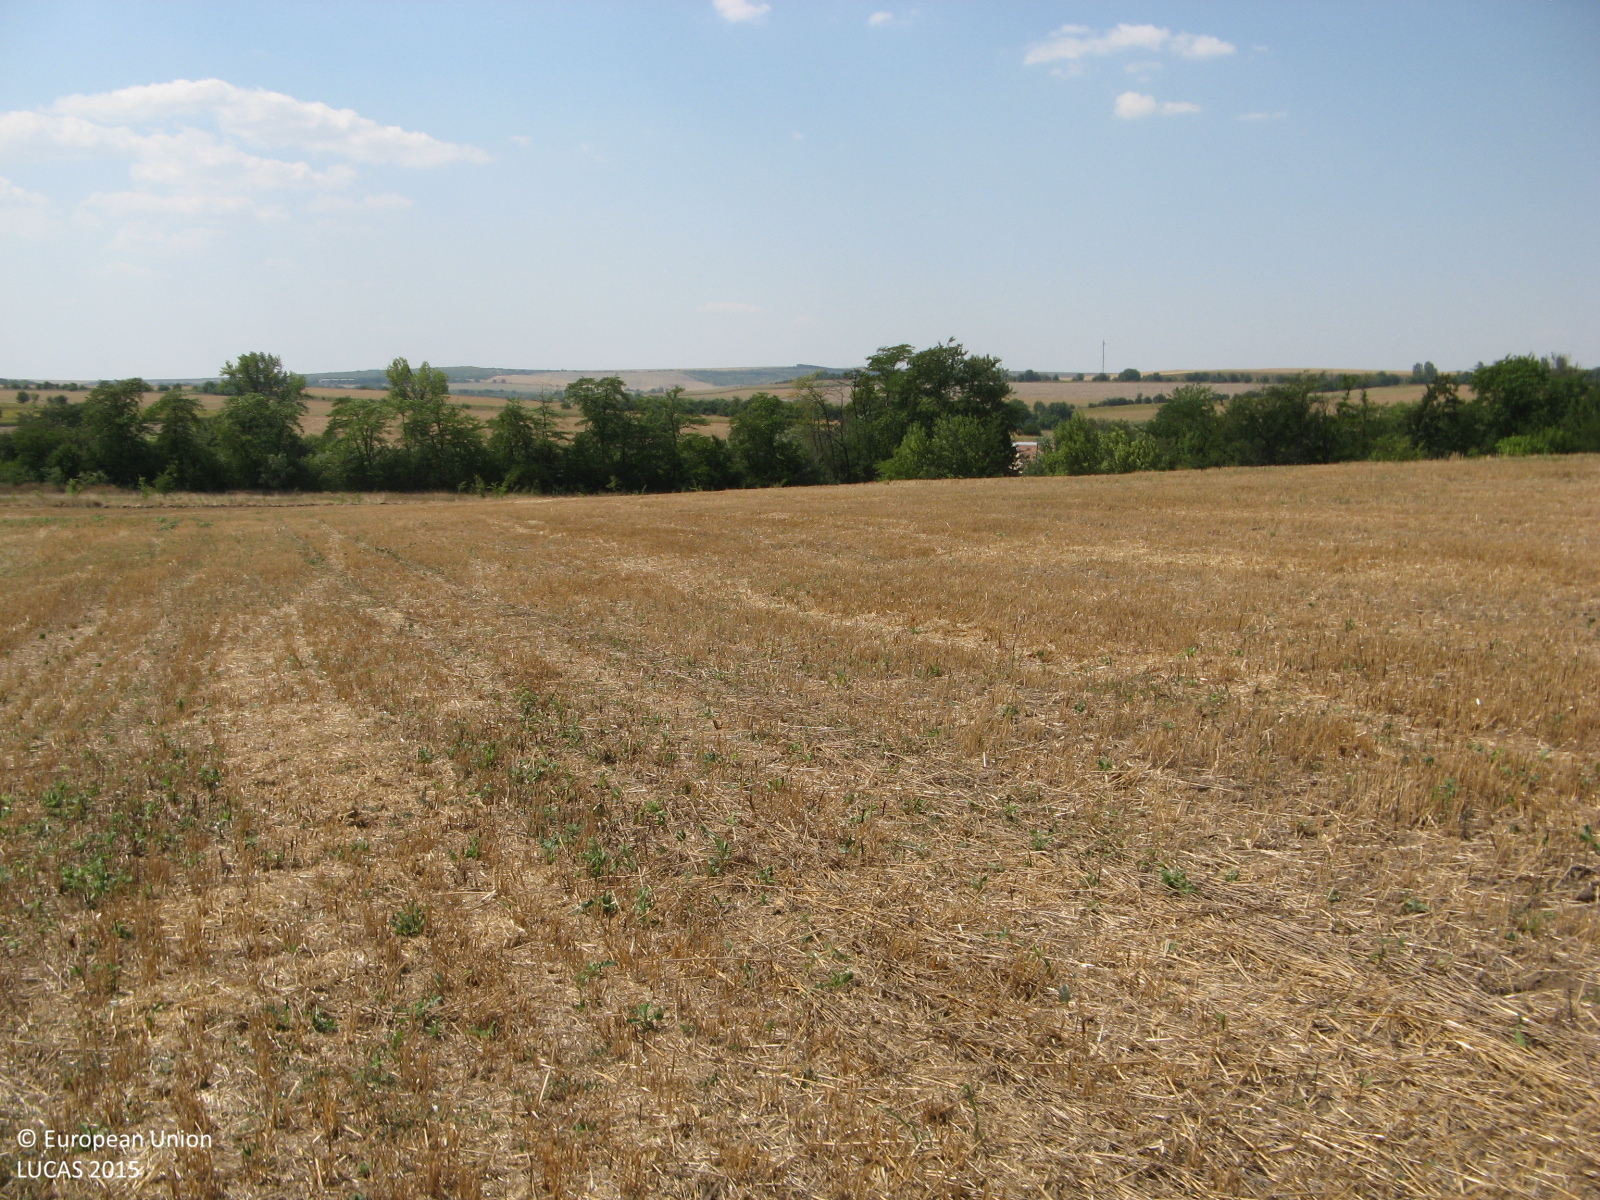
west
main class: Cropland
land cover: Common wheat
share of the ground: 50 - 75 %
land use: Agriculture (excluding fallow land and kitchen gardens)
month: August
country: BG
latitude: 43.3666
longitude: 25.3418
